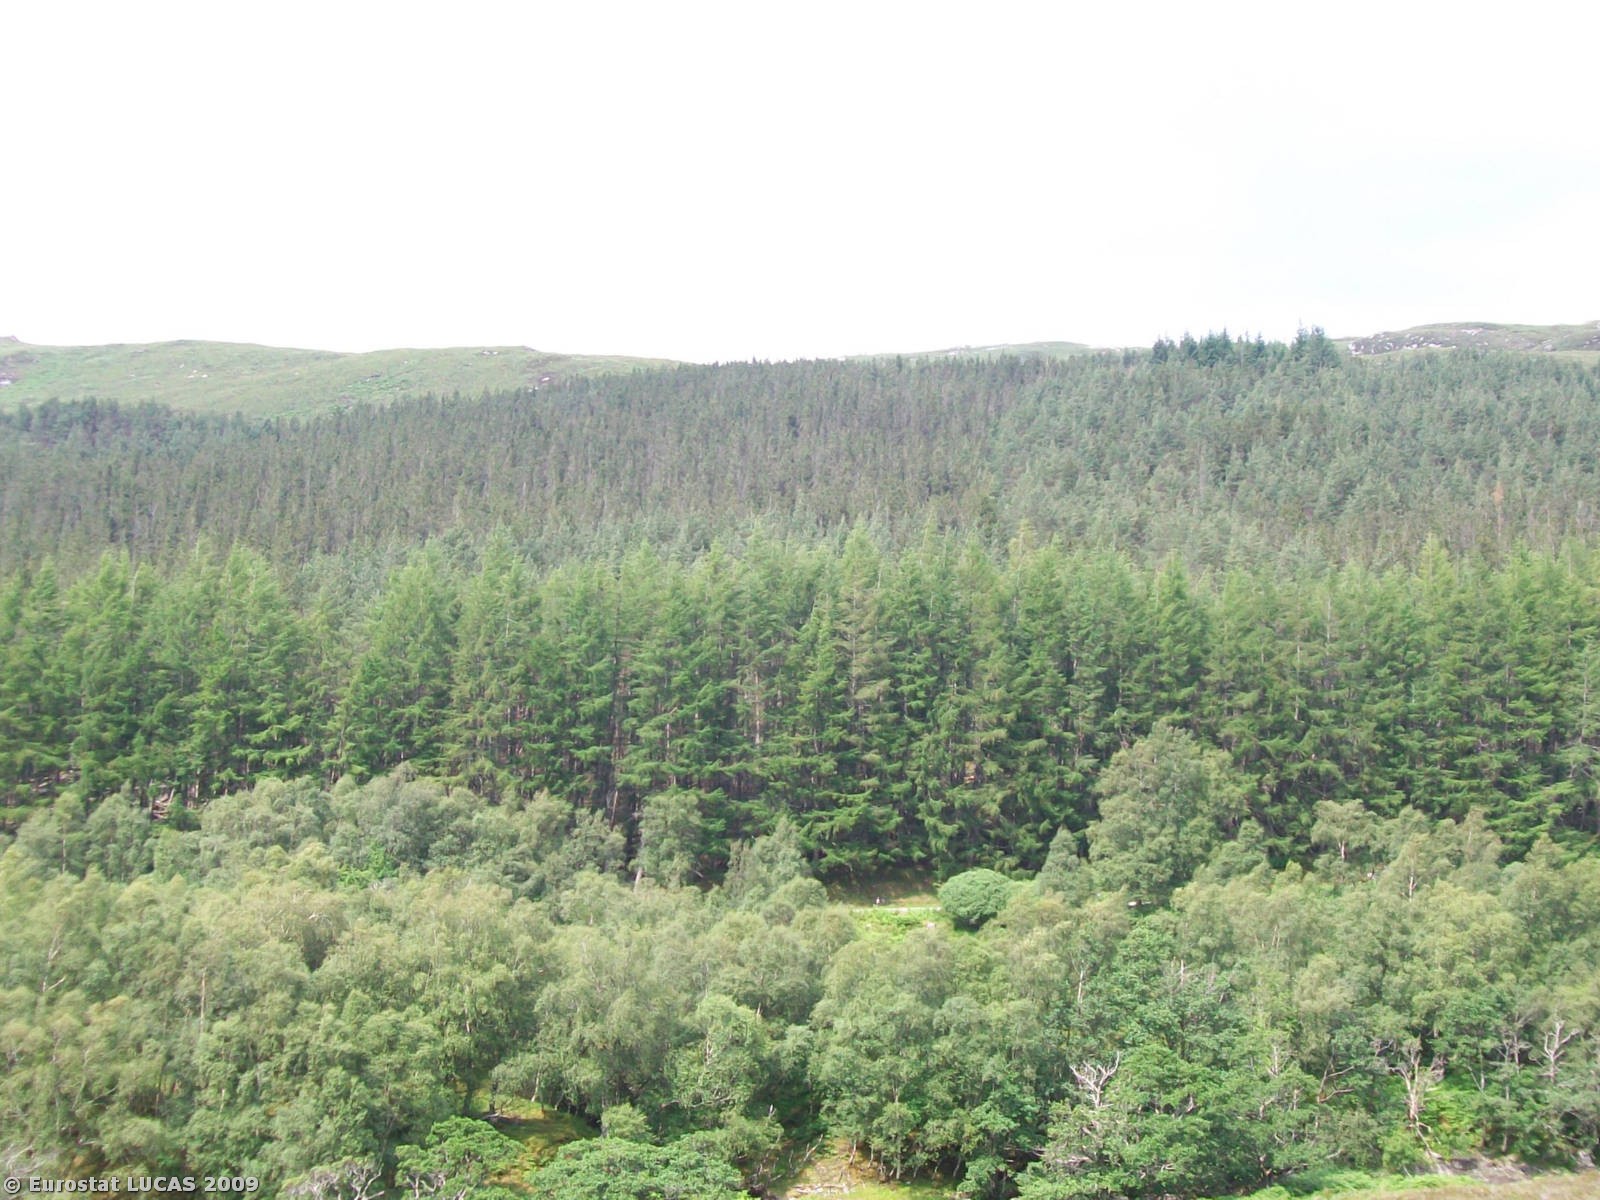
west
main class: Shrubland
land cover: Shrubland without tree cover
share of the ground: > 75 %
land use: Unused
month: July
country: GB
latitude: 57.7925
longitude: -5.1605
